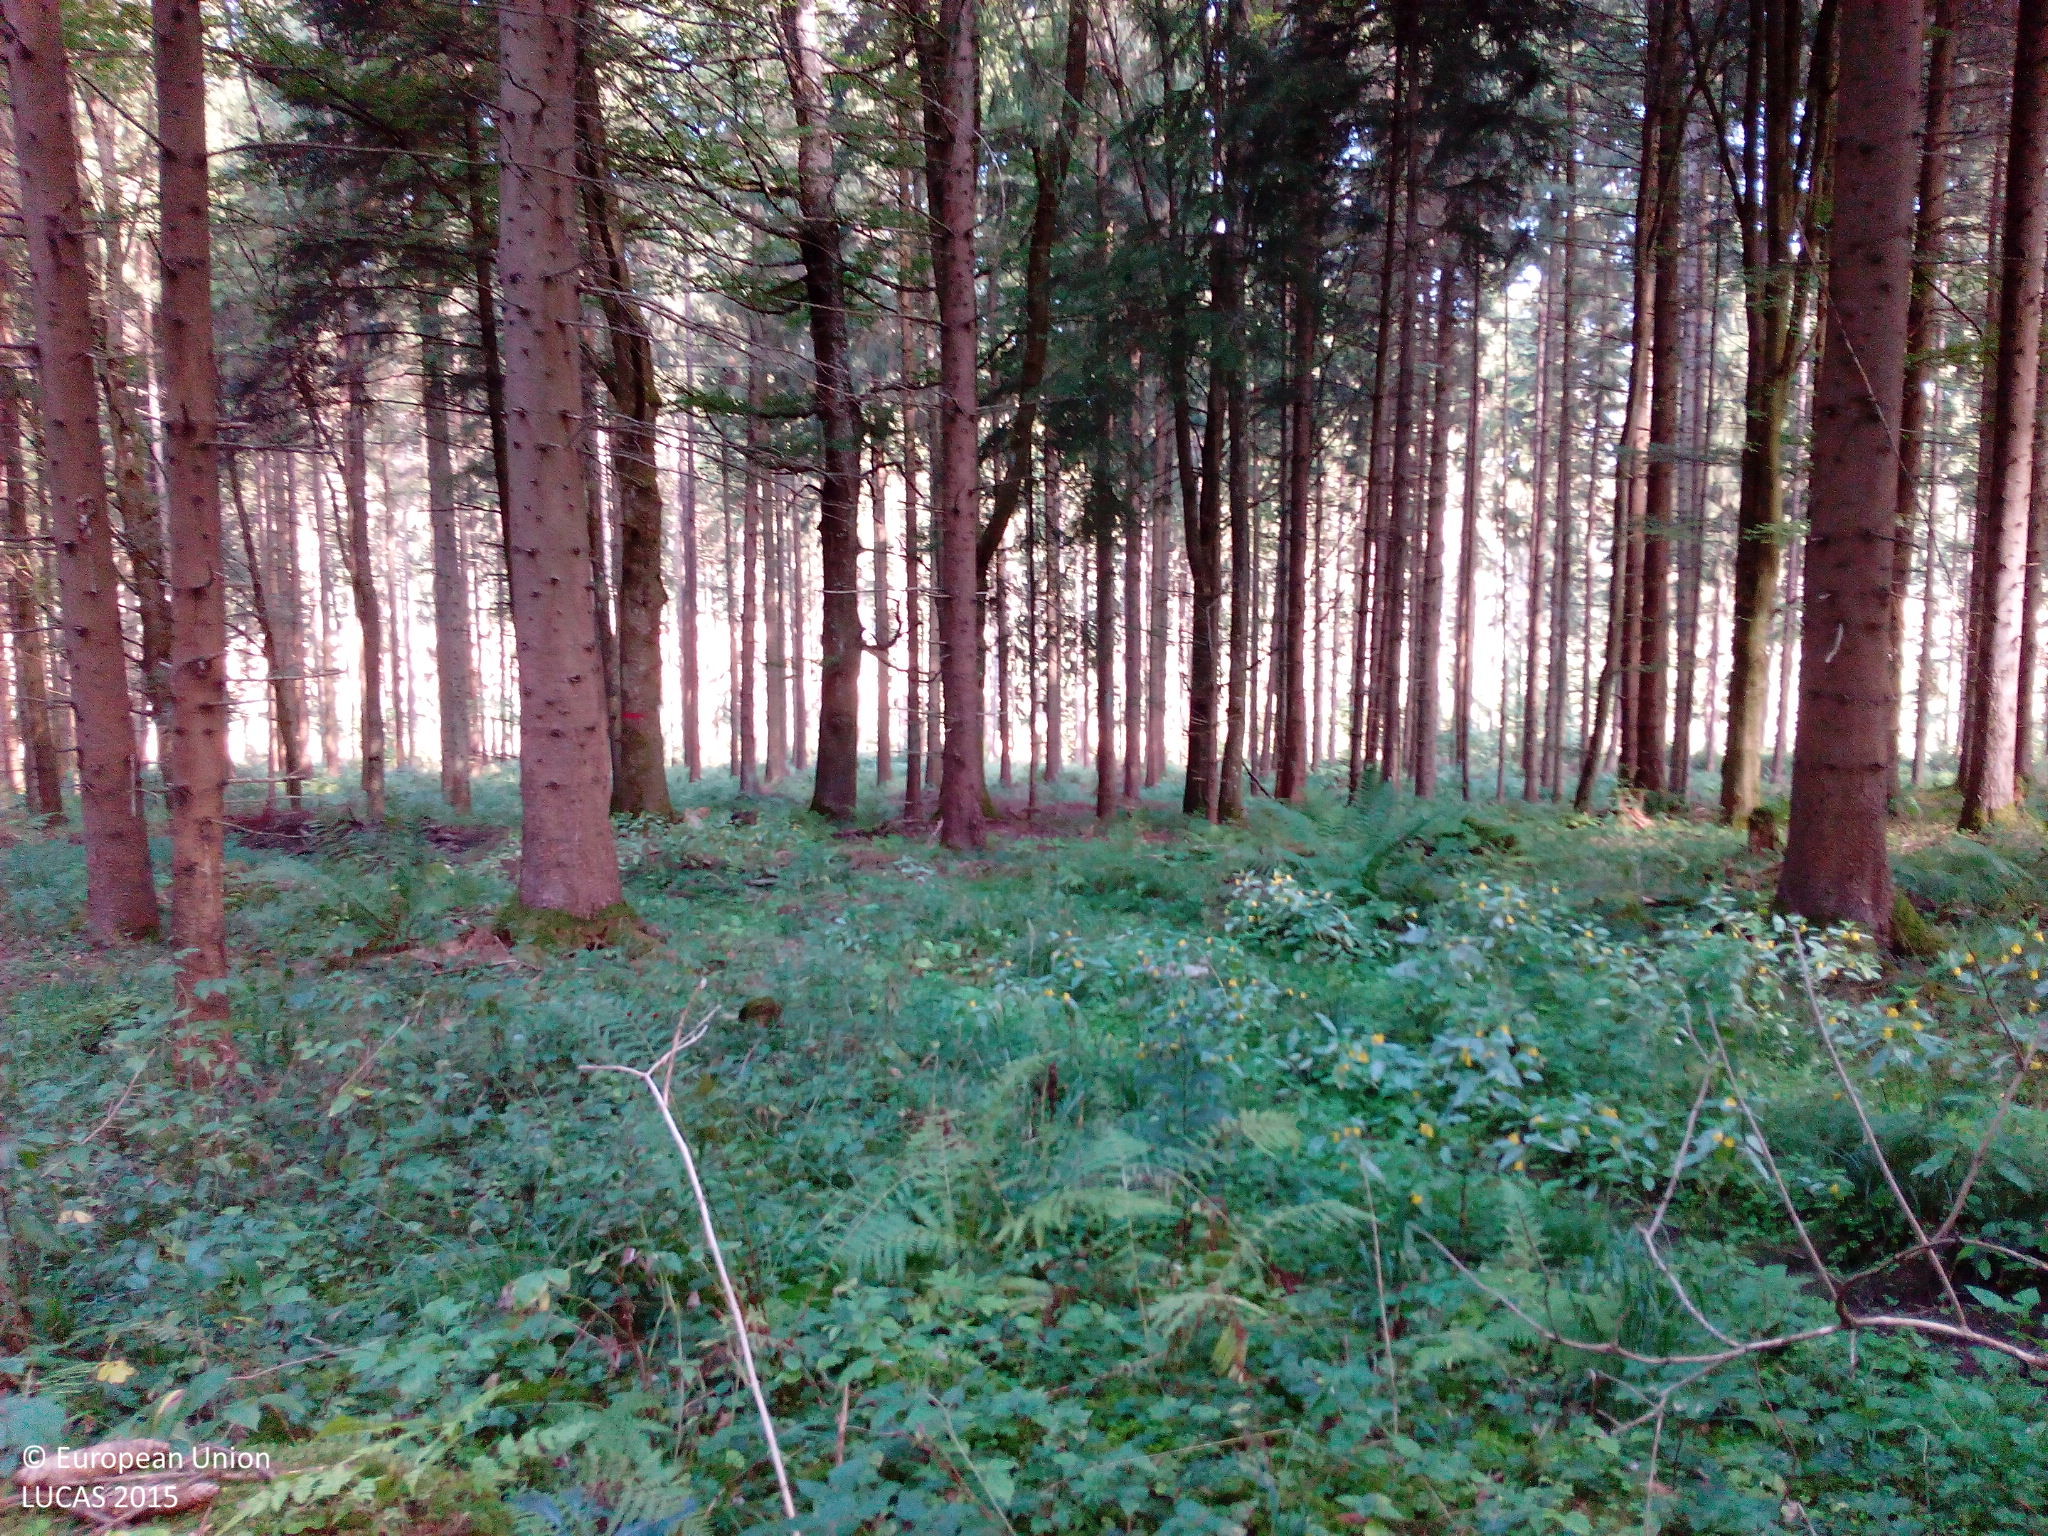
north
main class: Woodland
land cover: Spruce dominated coniferous woodland
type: hemiboreal forest and nemoral coniferous forest and mixed broadleaved-coniferous forest
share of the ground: 50 - 75 %
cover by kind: coniferous forest trees 55 %, herbaceous plants 20 %, lichens and mosses 10 %, broadleaved forest trees 5 %, shrubs 5 %, unconsolidated bare surface 5 %
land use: Forestry
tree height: > 5 m
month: September
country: DE
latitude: 48.1785
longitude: 8.5887
